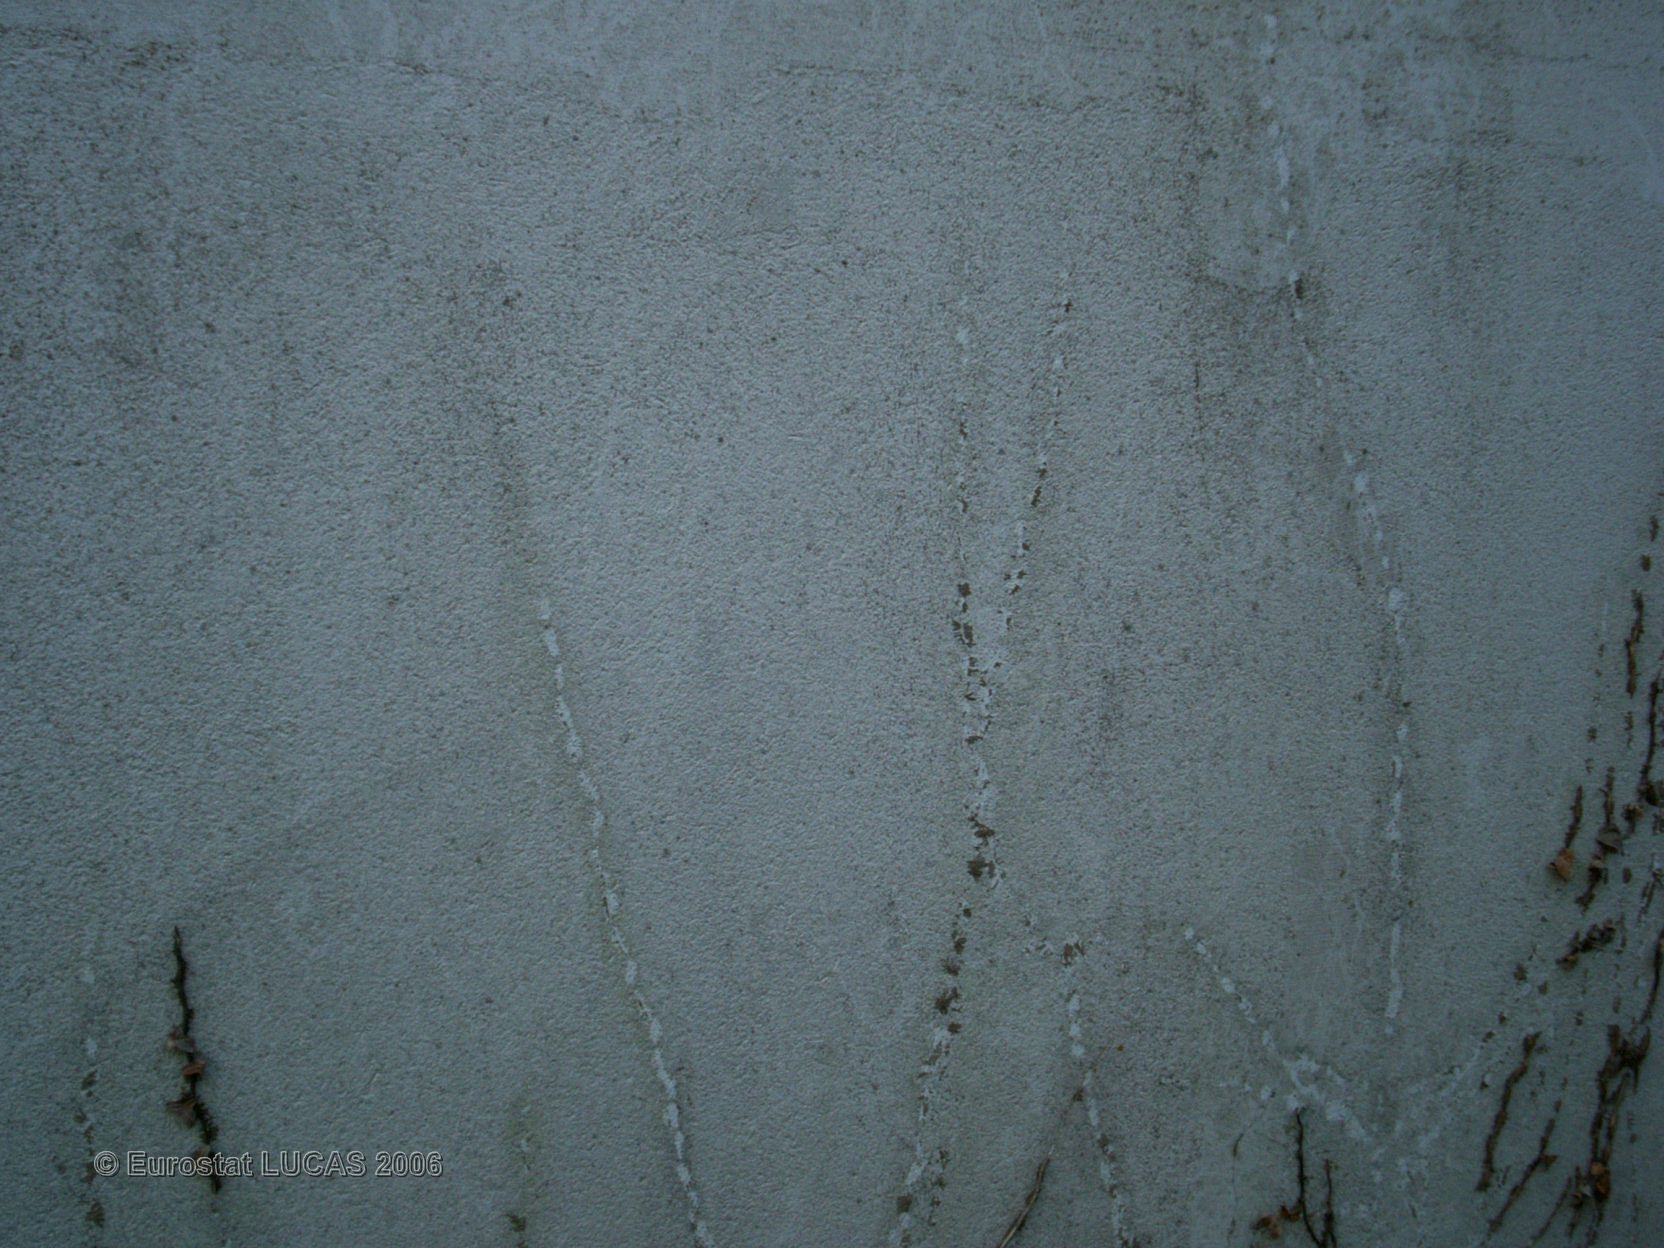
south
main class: Grassland
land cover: Grassland without tree/shrub cover
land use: Residential
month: April
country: FR
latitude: 47.7059
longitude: -3.4411
